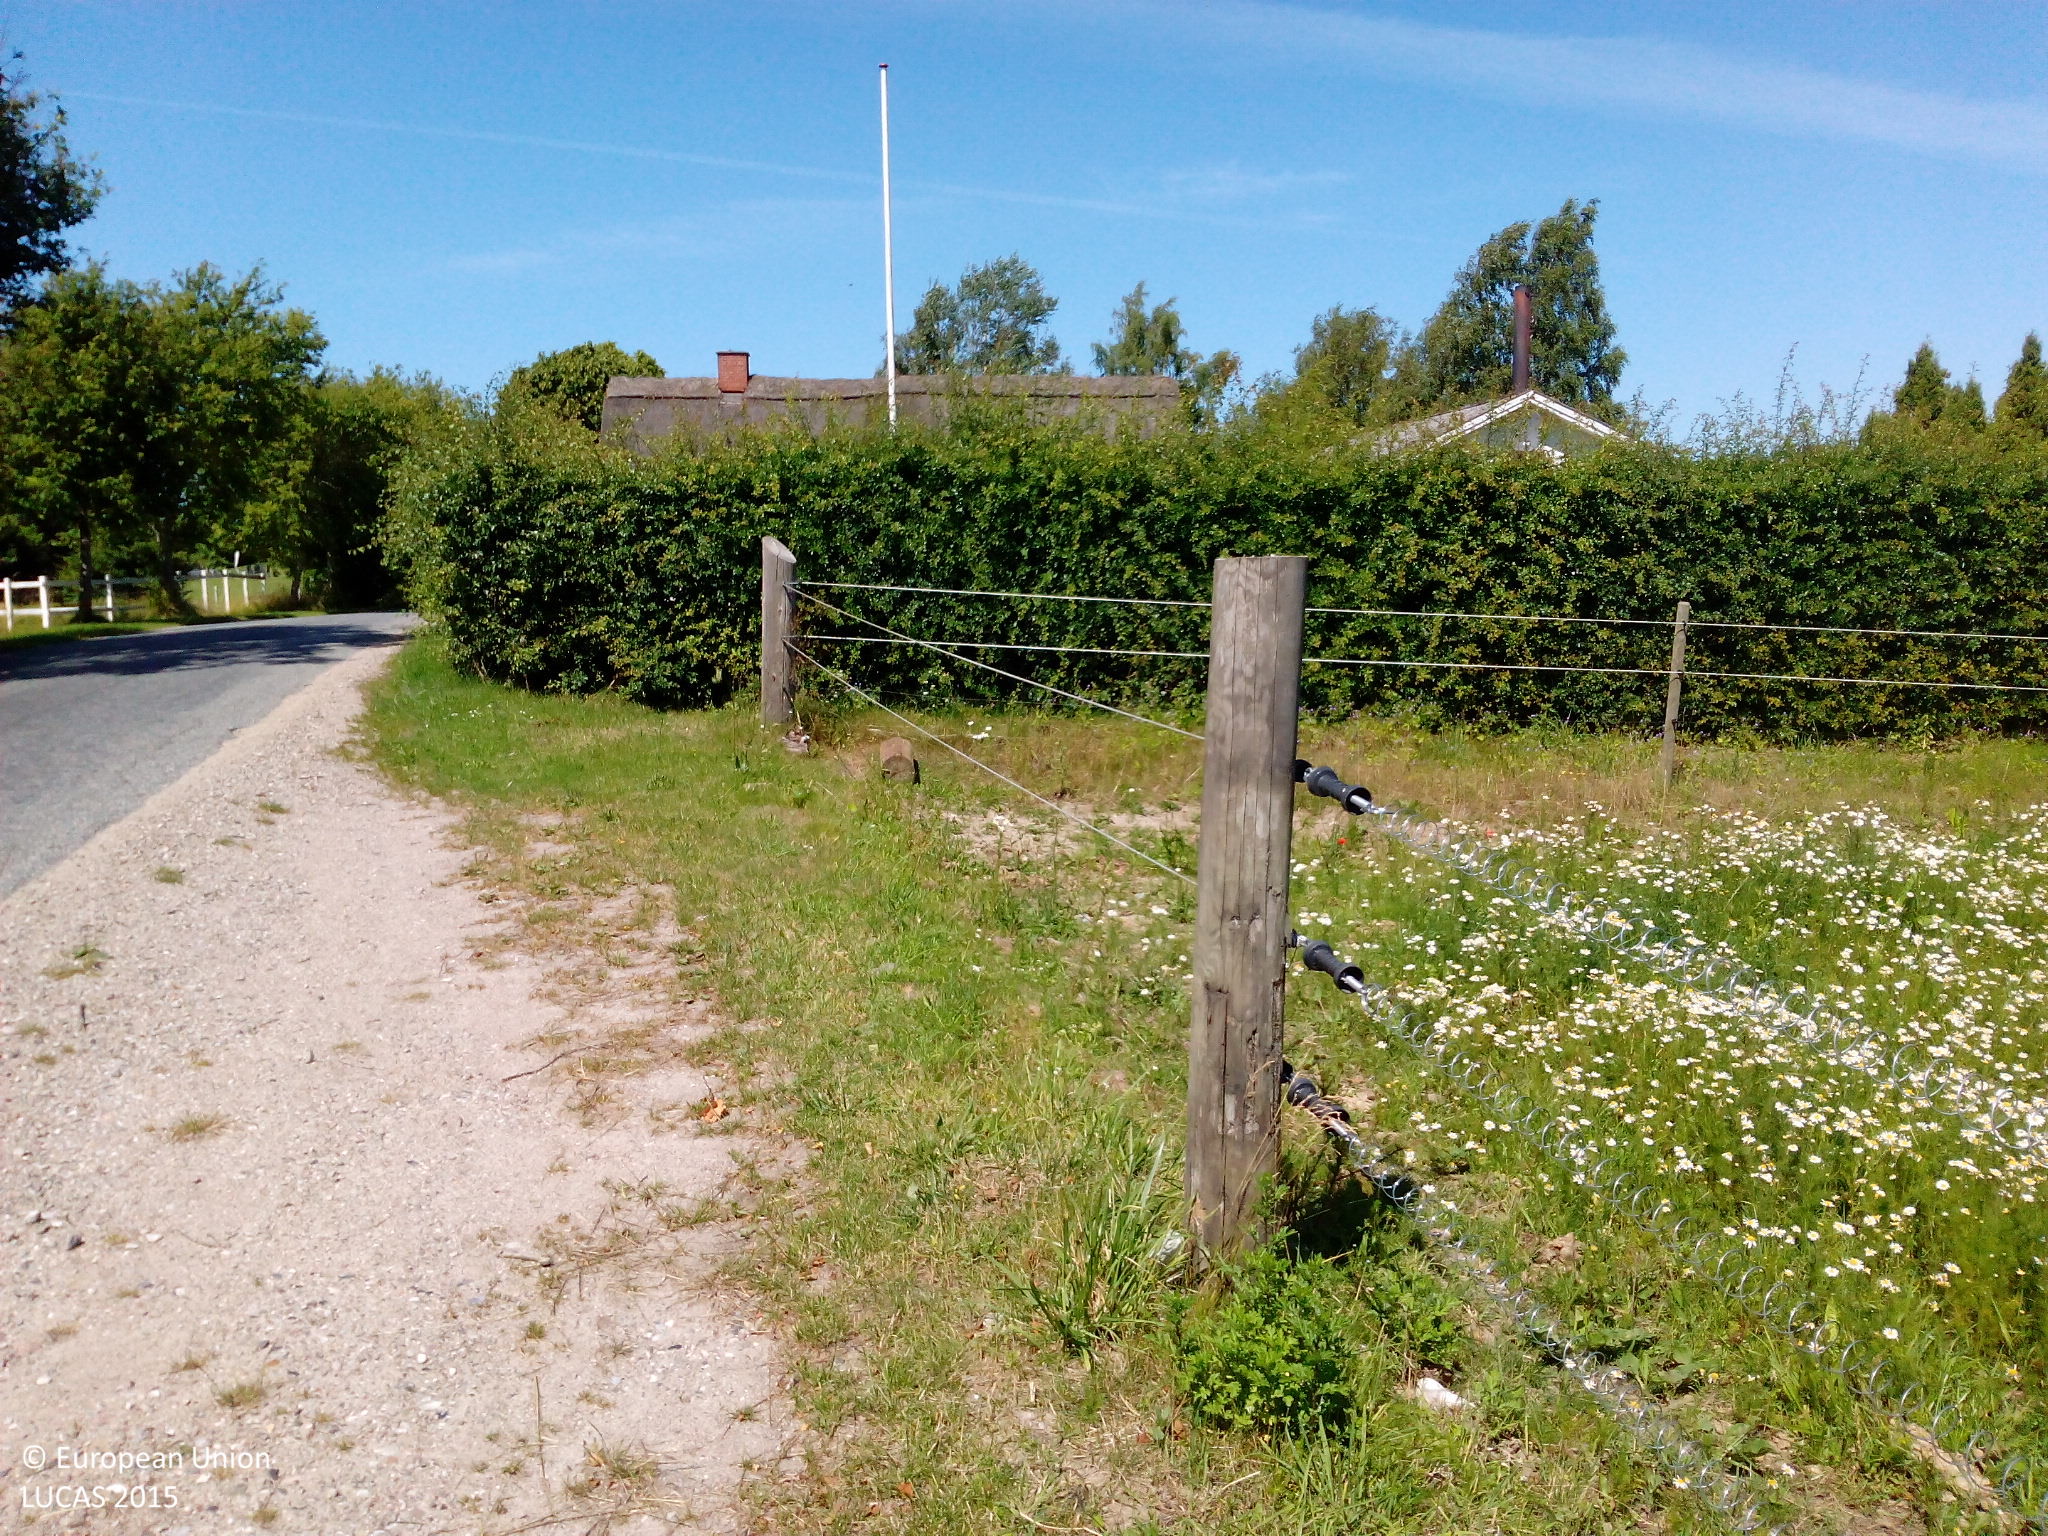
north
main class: Grassland
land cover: Grassland without tree/shrub cover
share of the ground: > 75 %
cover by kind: herbaceous plants 100 %
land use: Agriculture (excluding fallow land and kitchen gardens)
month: July
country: DK
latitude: 55.4763
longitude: 11.6282
